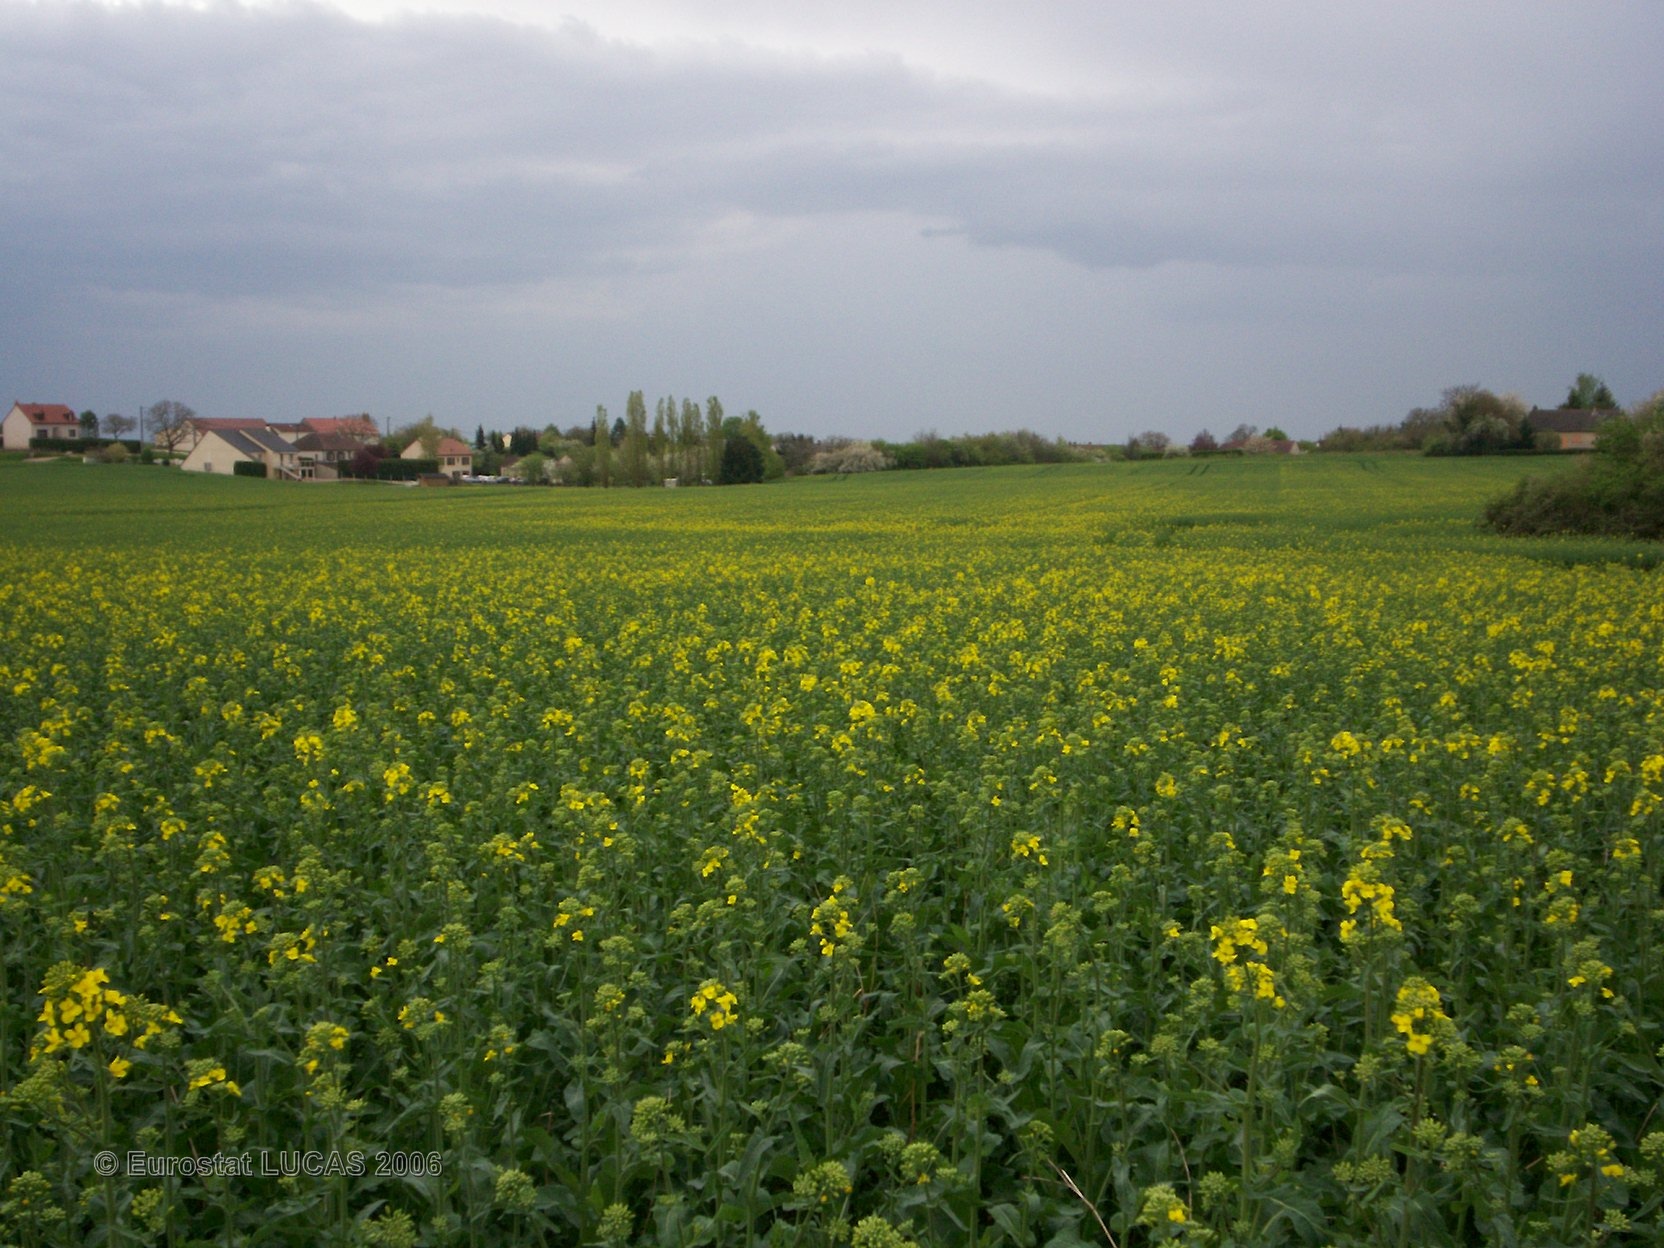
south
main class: Cropland
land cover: Rape and turnip rape
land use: Agriculture (excluding fallow land and kitchen gardens)
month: April
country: FR
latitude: 47.2947
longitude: 2.9728
